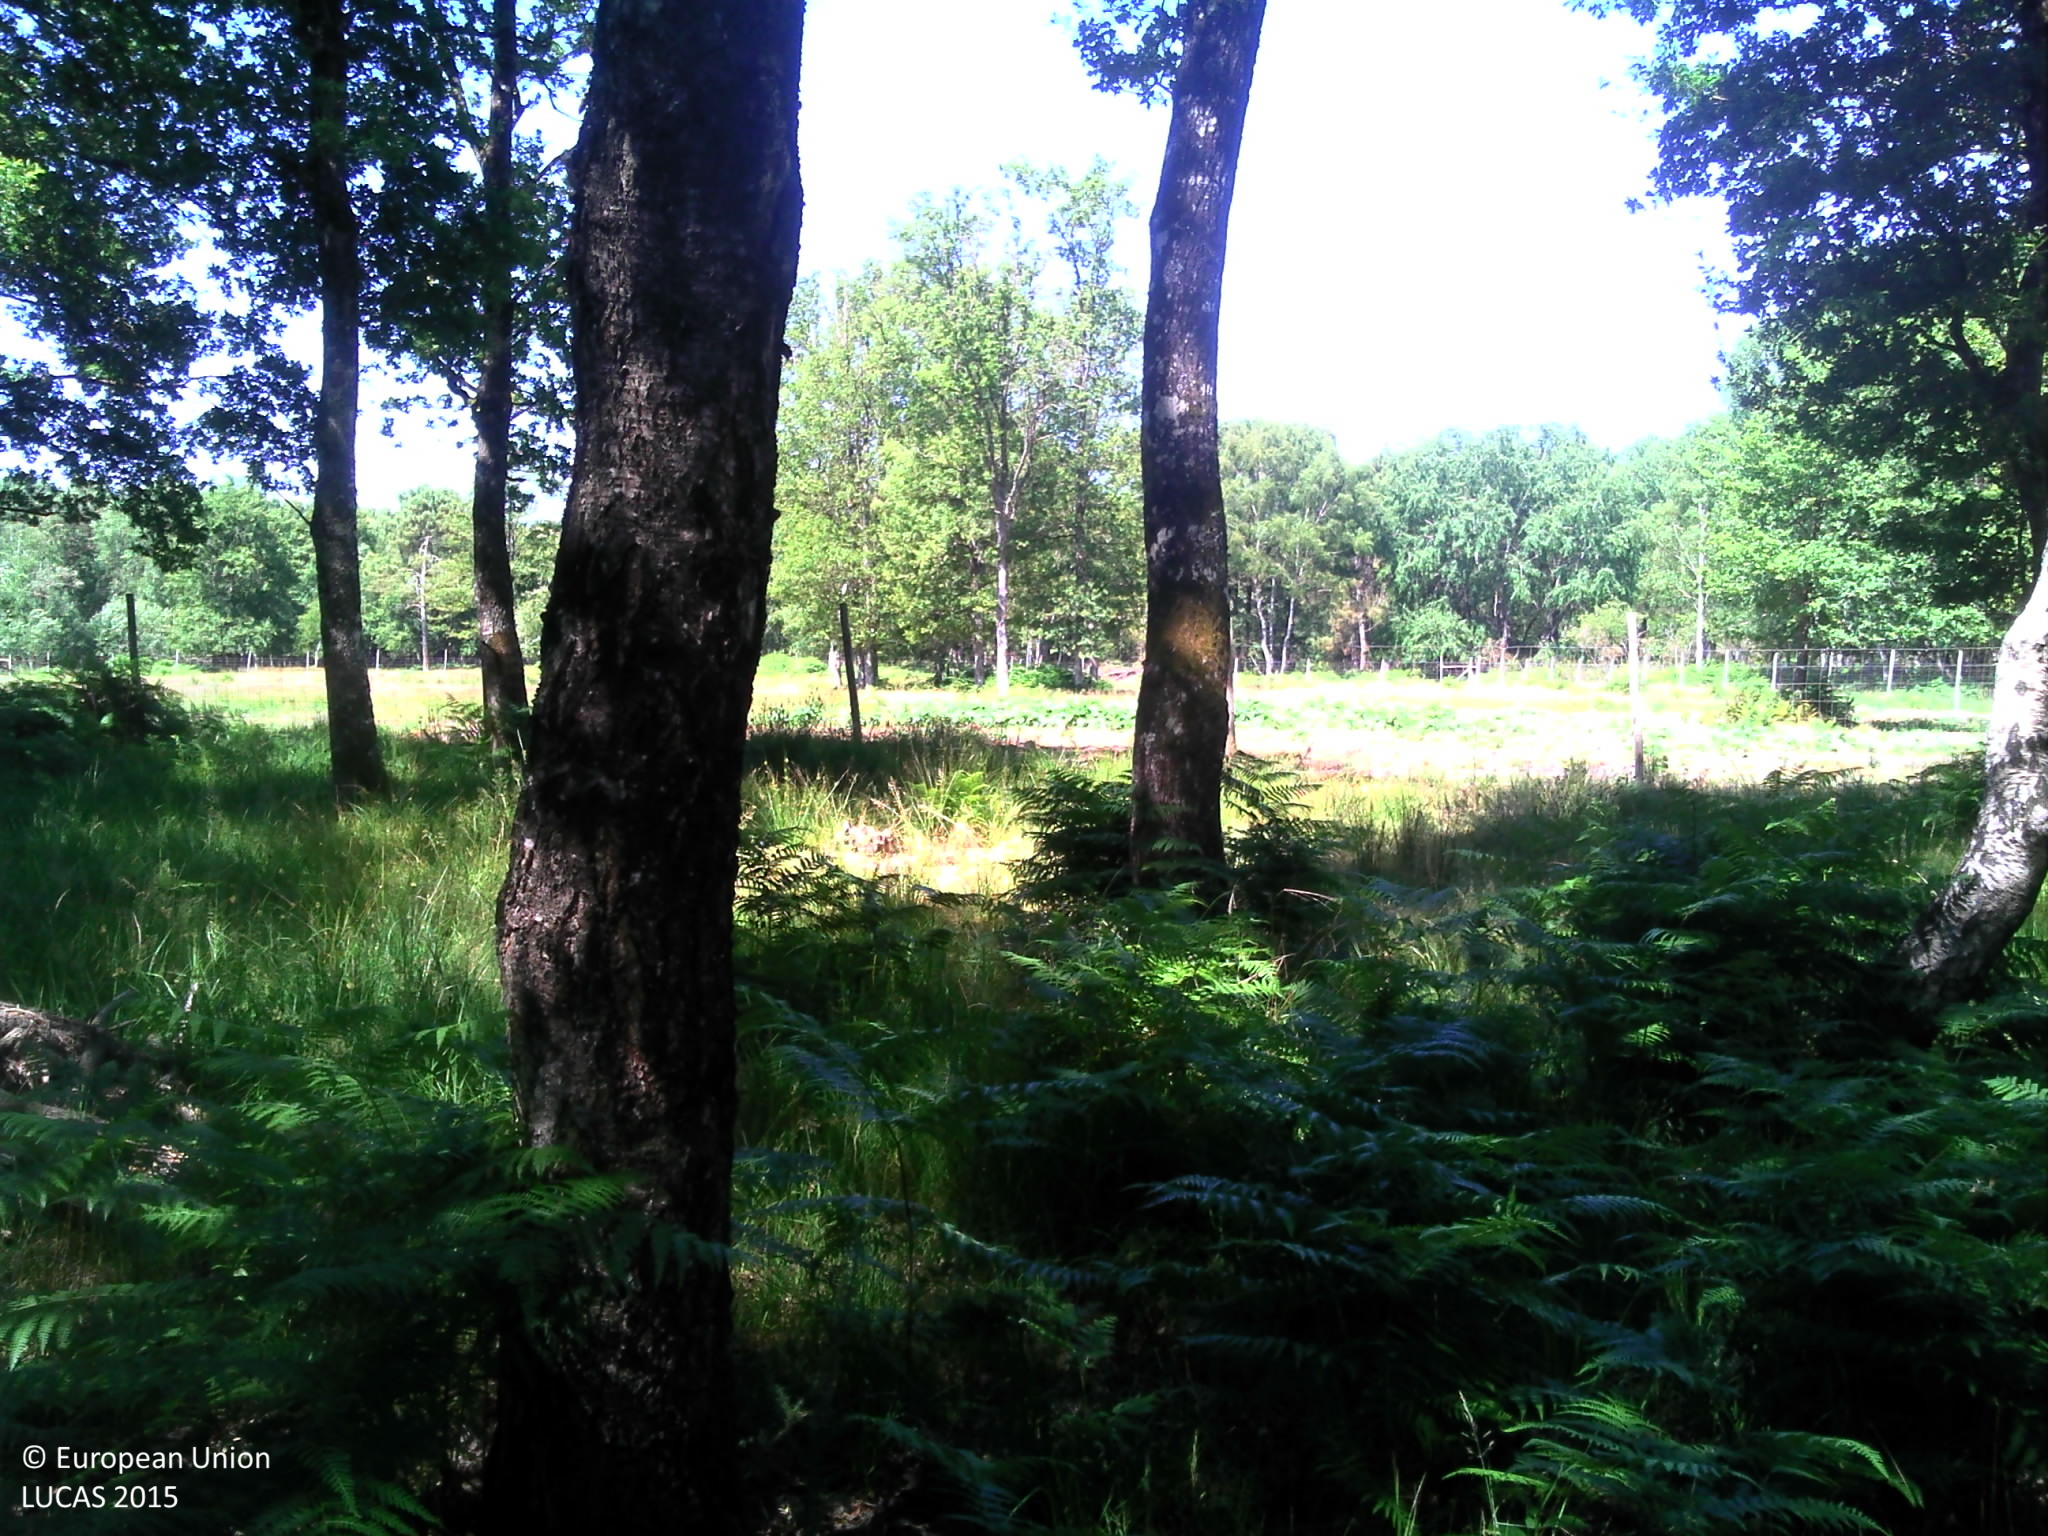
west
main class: Woodland
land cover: Broadleaved woodland
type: mesophytic deciduous forest
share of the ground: > 75 %
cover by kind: broadleaved forest trees 70 %, herbaceous plants 20 %, shrubs 5 %, lichens and mosses 5 %
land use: Forestry
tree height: > 5 m
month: June
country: FR
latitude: 47.3621
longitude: 0.3251
